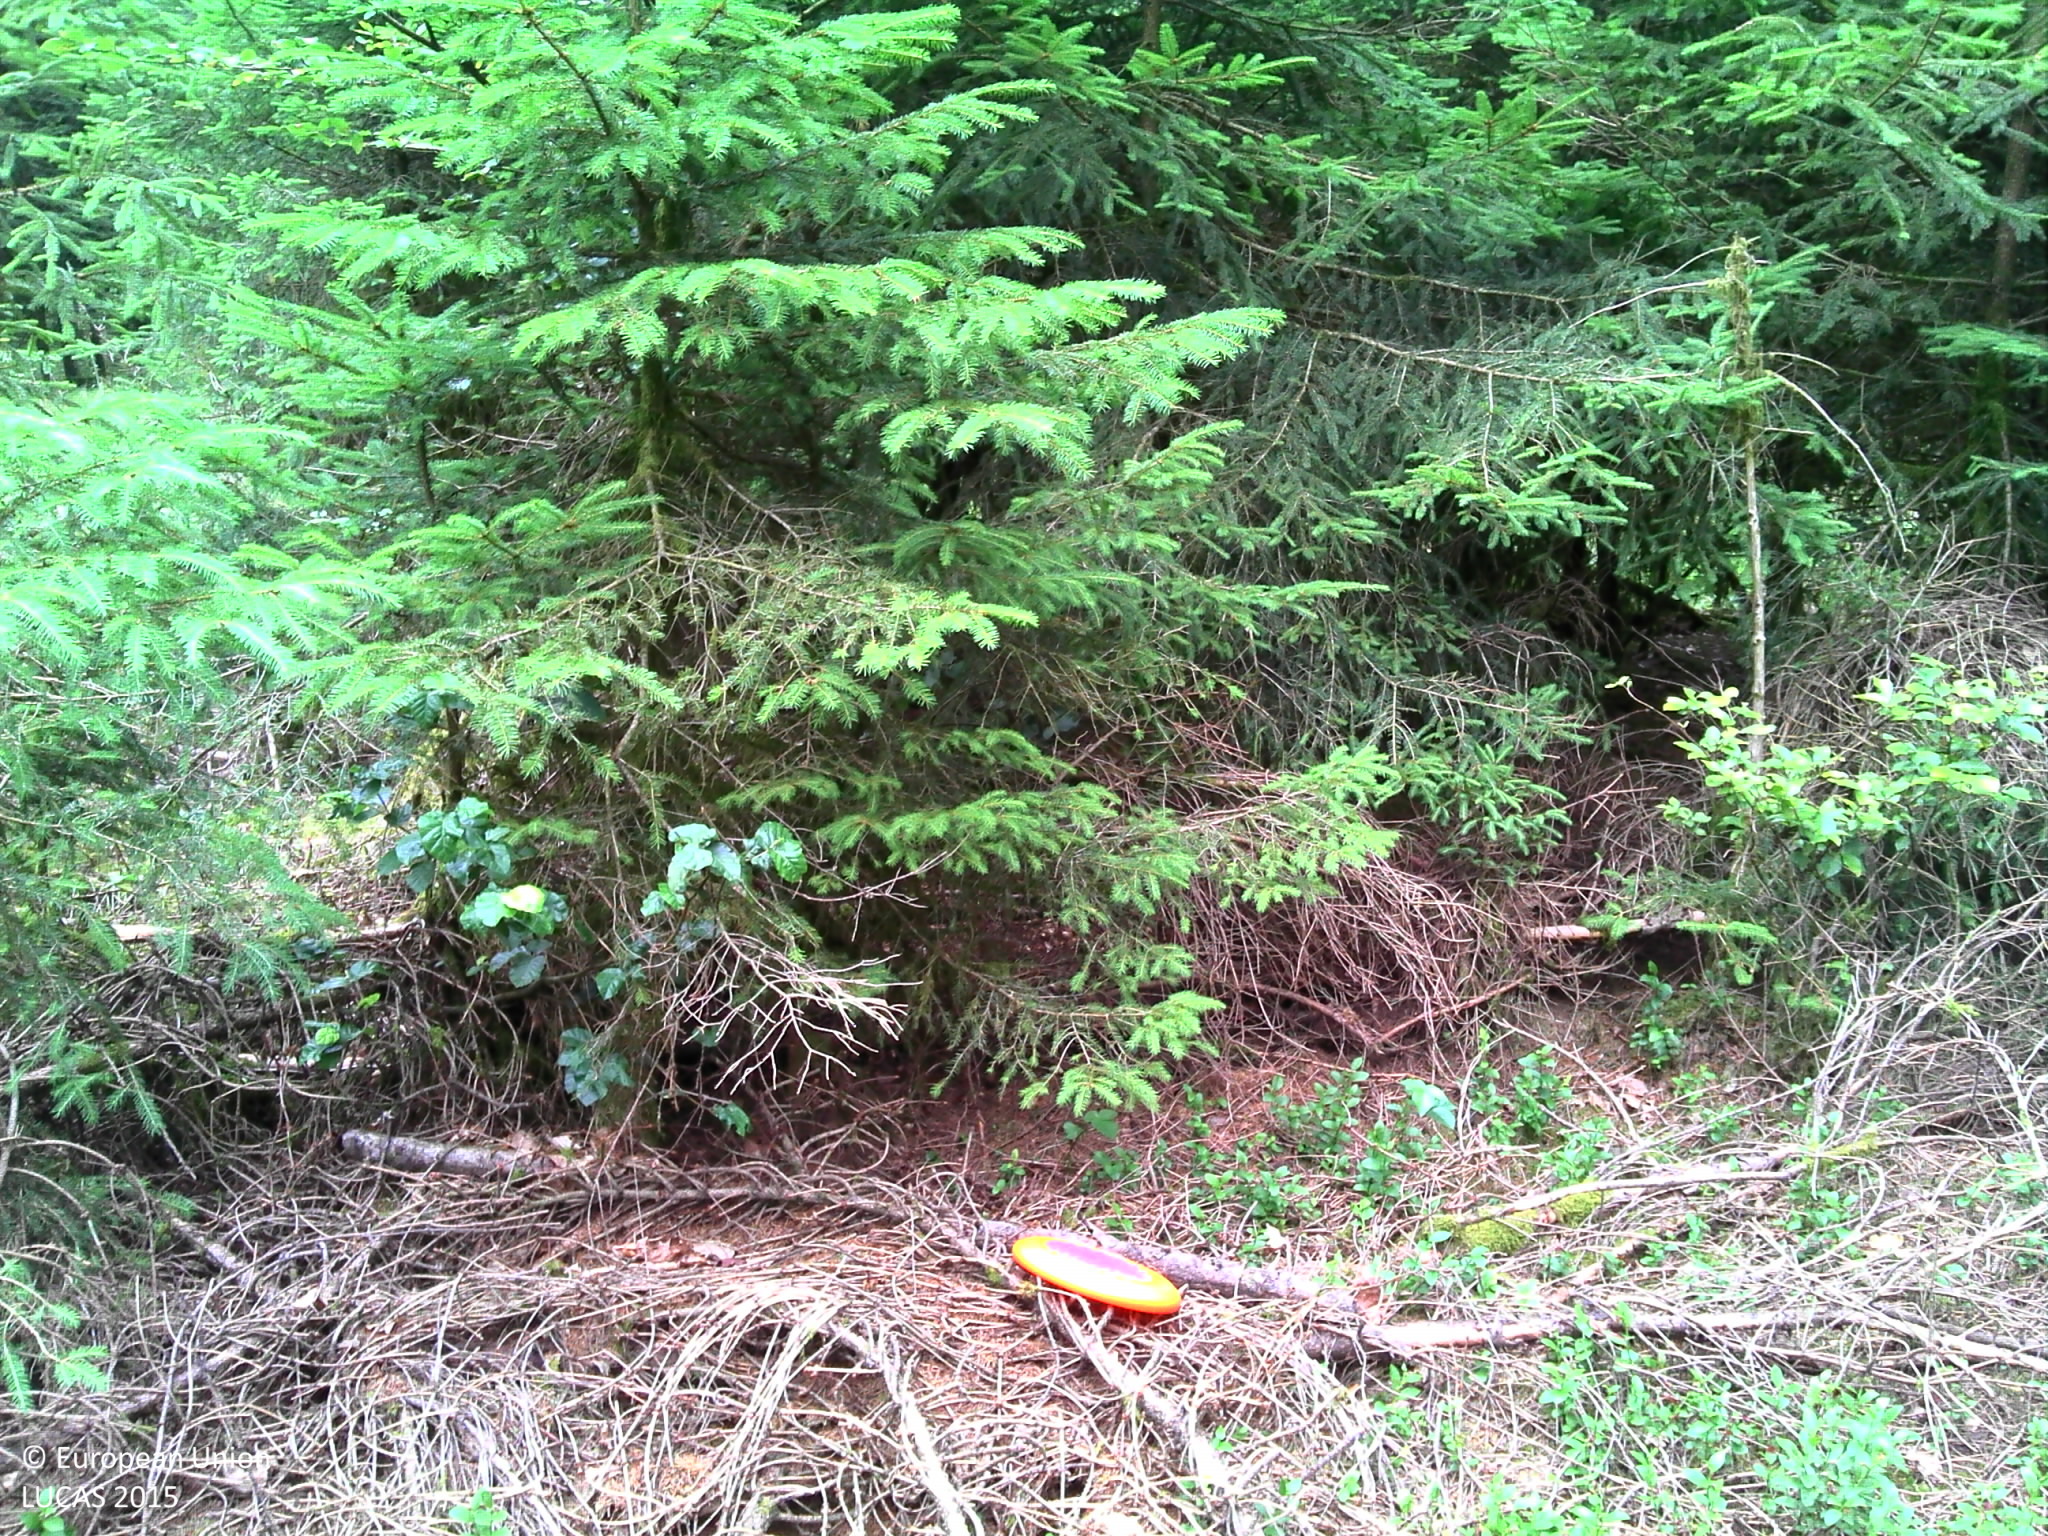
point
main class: Woodland
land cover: Spruce dominated coniferous woodland
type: hemiboreal forest and nemoral coniferous forest and mixed broadleaved-coniferous forest
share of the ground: 50 - 75 %
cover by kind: coniferous forest trees 60 %, herbaceous plants 20 %, shrubs 10 %, unconsolidated bare surface 10 %
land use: Forestry
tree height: > 5 m
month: July
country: BE
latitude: 49.7571
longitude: 5.5983
